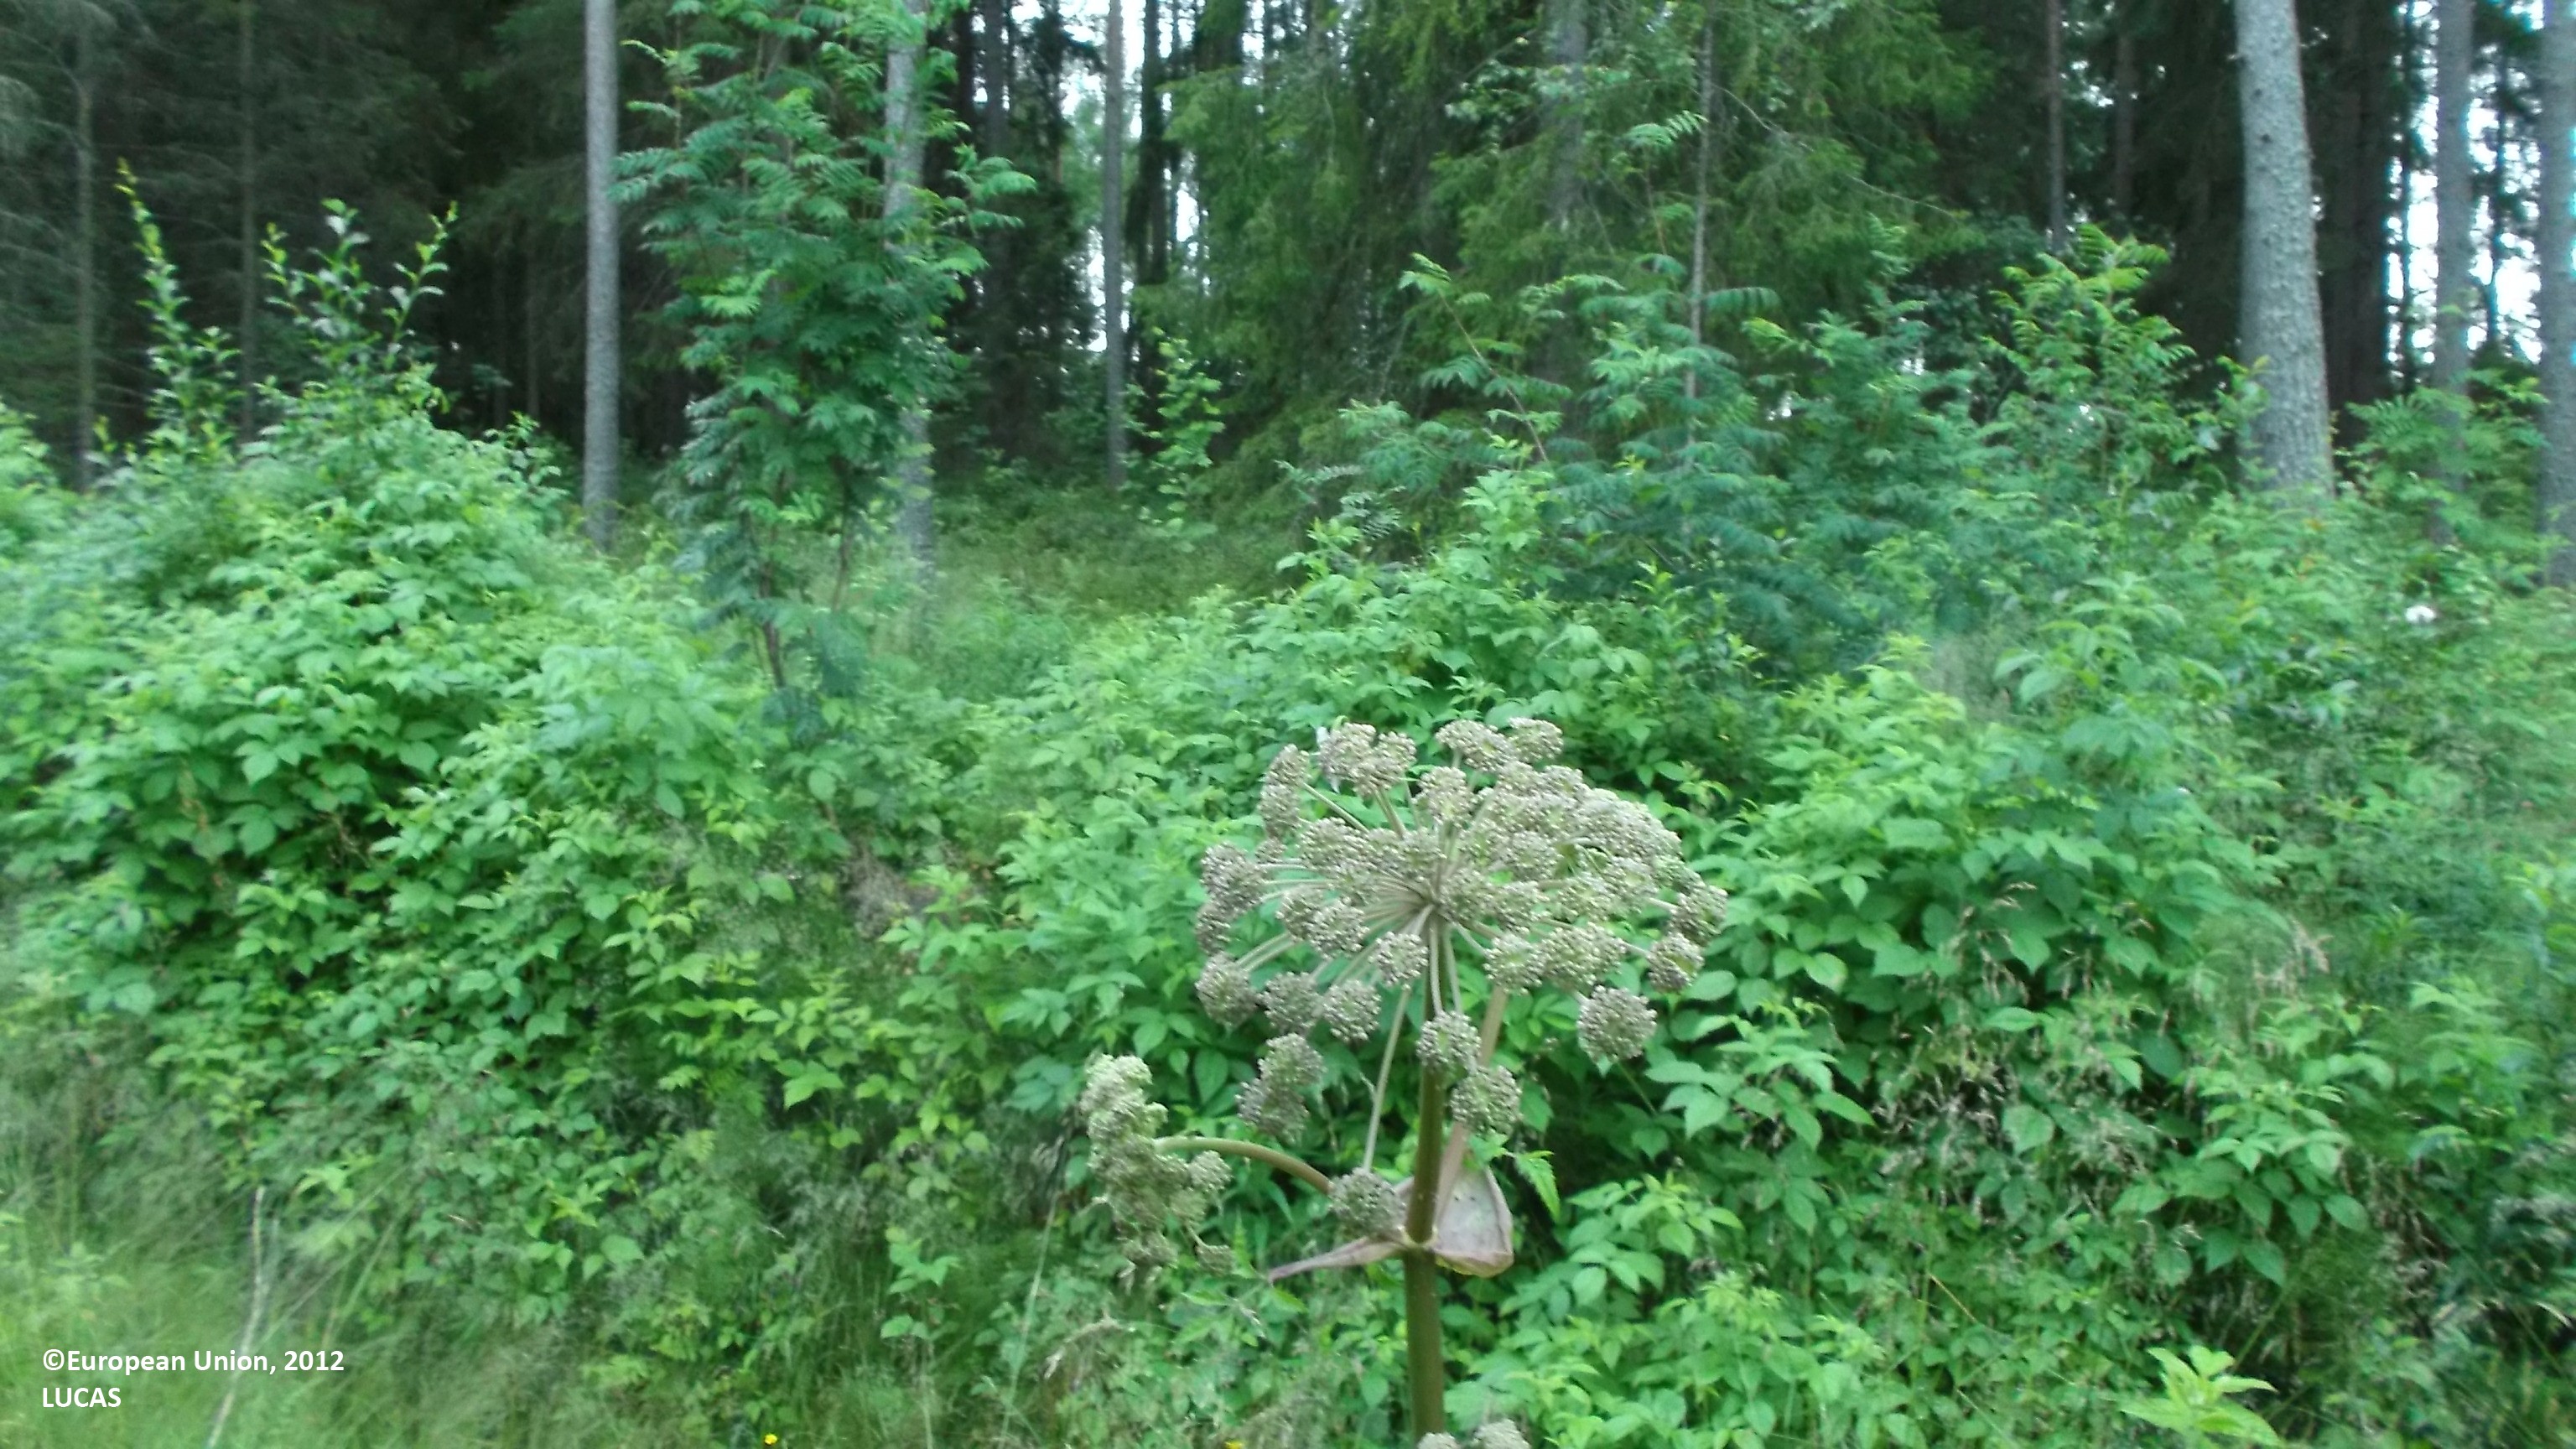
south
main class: Shrubland
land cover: Shrubland with sparse tree cover
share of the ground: > 75 %
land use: Forestry
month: July
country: FI
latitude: 63.6991
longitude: 23.3889
